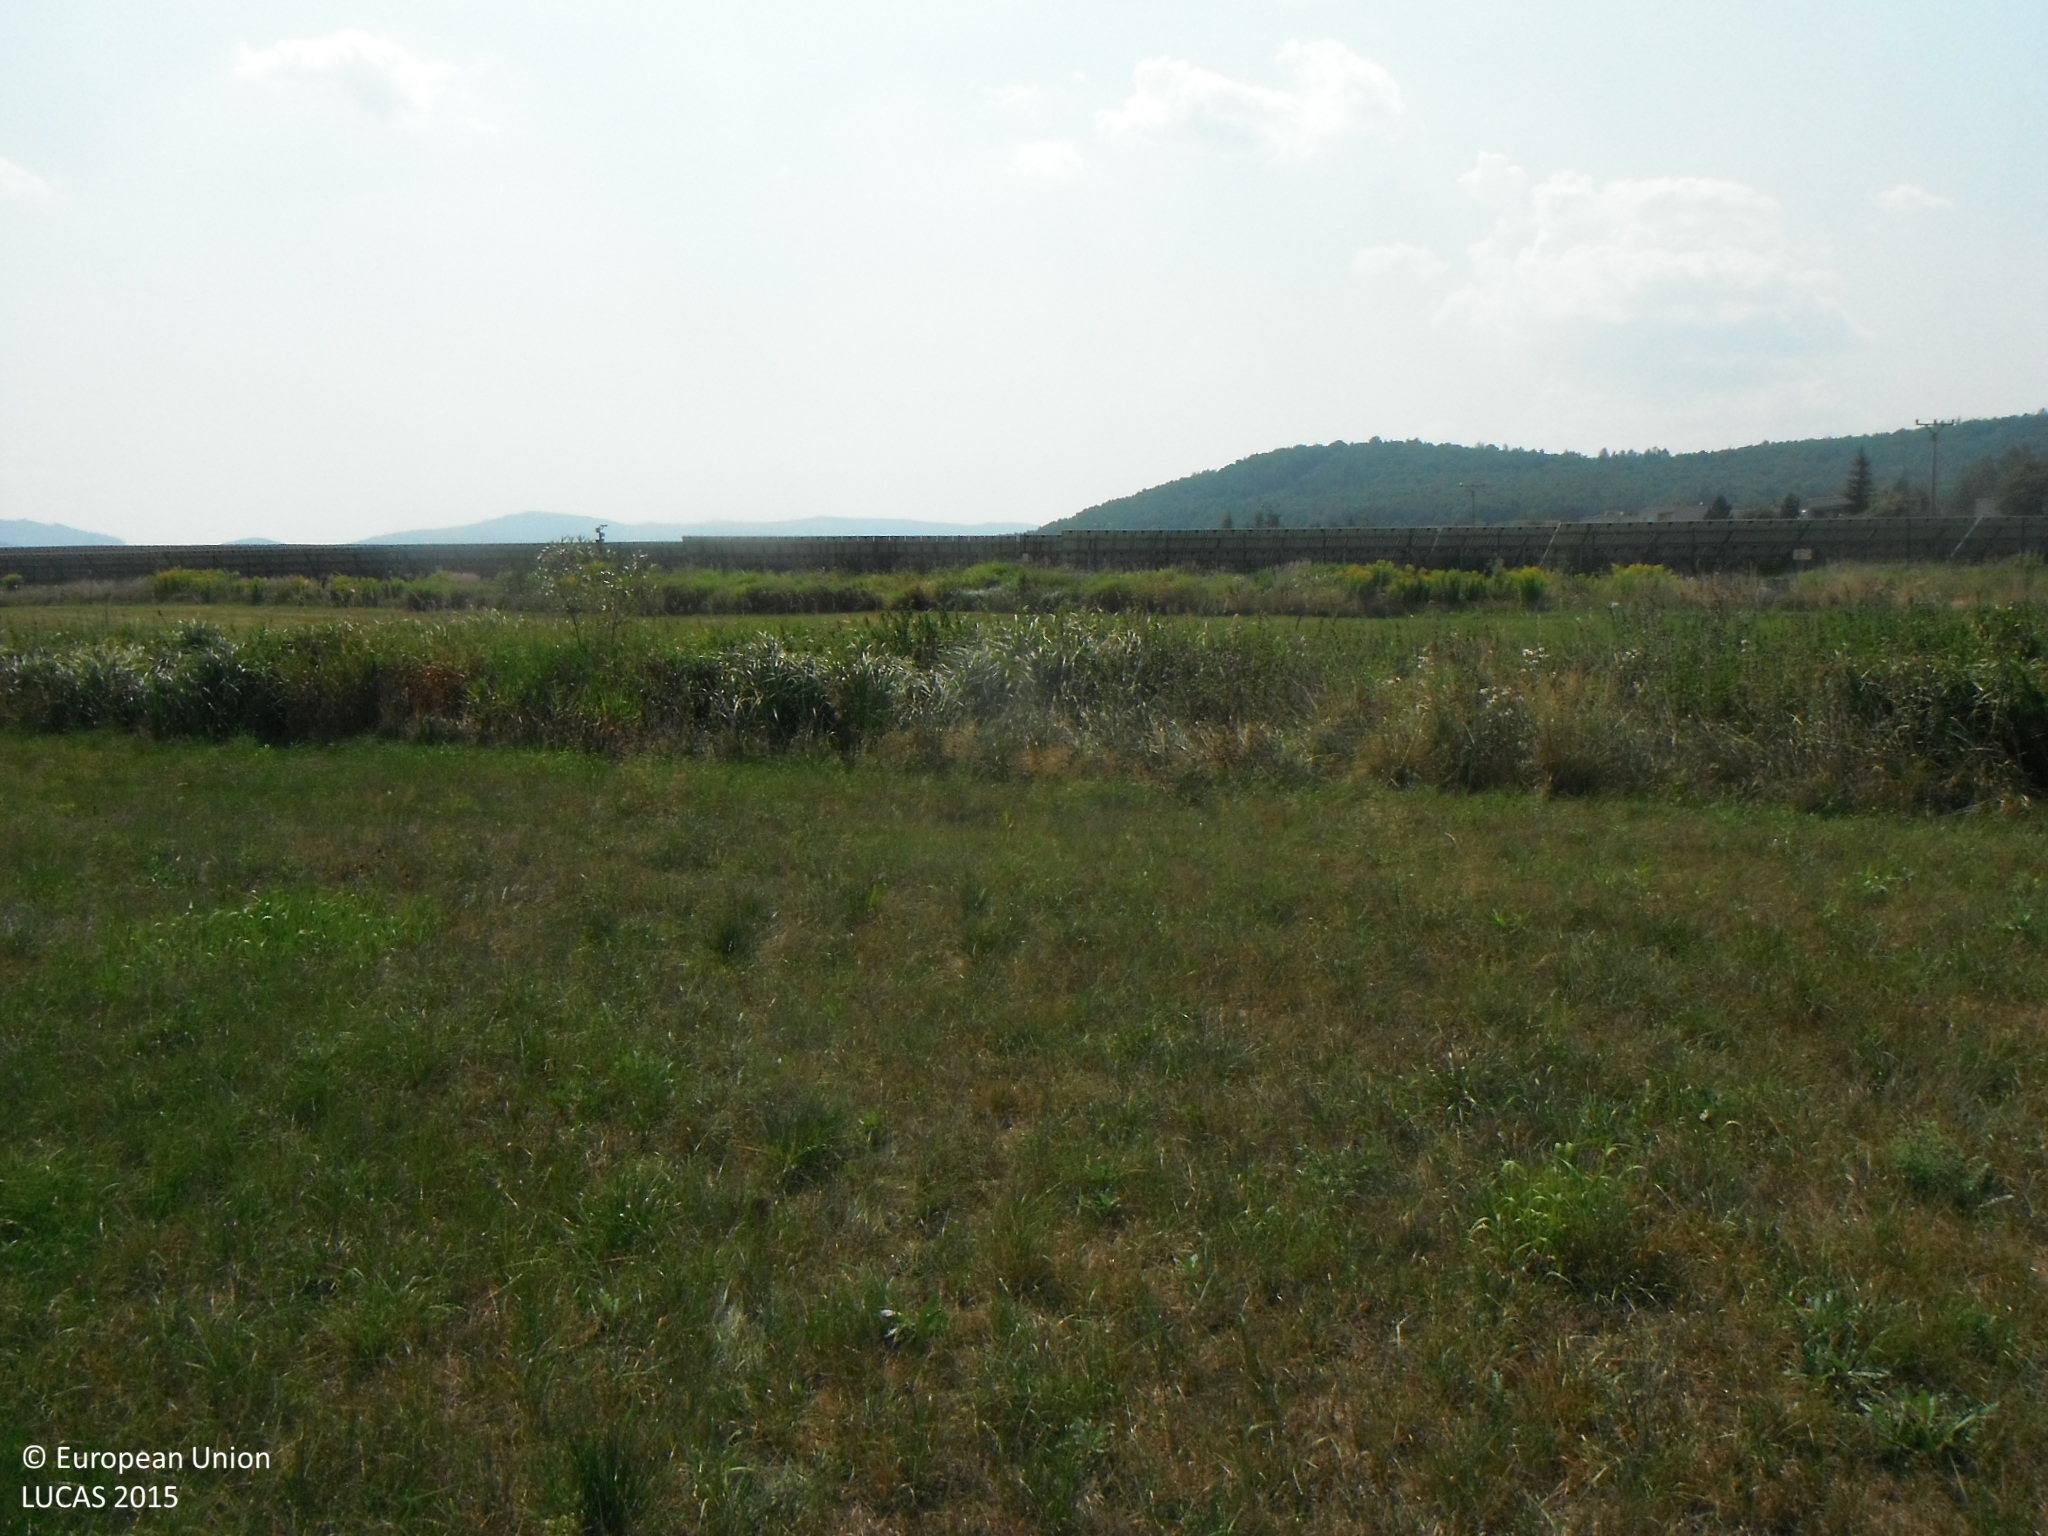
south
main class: Grassland
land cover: Grassland without tree/shrub cover
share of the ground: > 75 %
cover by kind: herbaceous plants 100 %
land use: Agriculture (excluding fallow land and kitchen gardens)
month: August
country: SK
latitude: 48.5538
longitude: 19.3037
